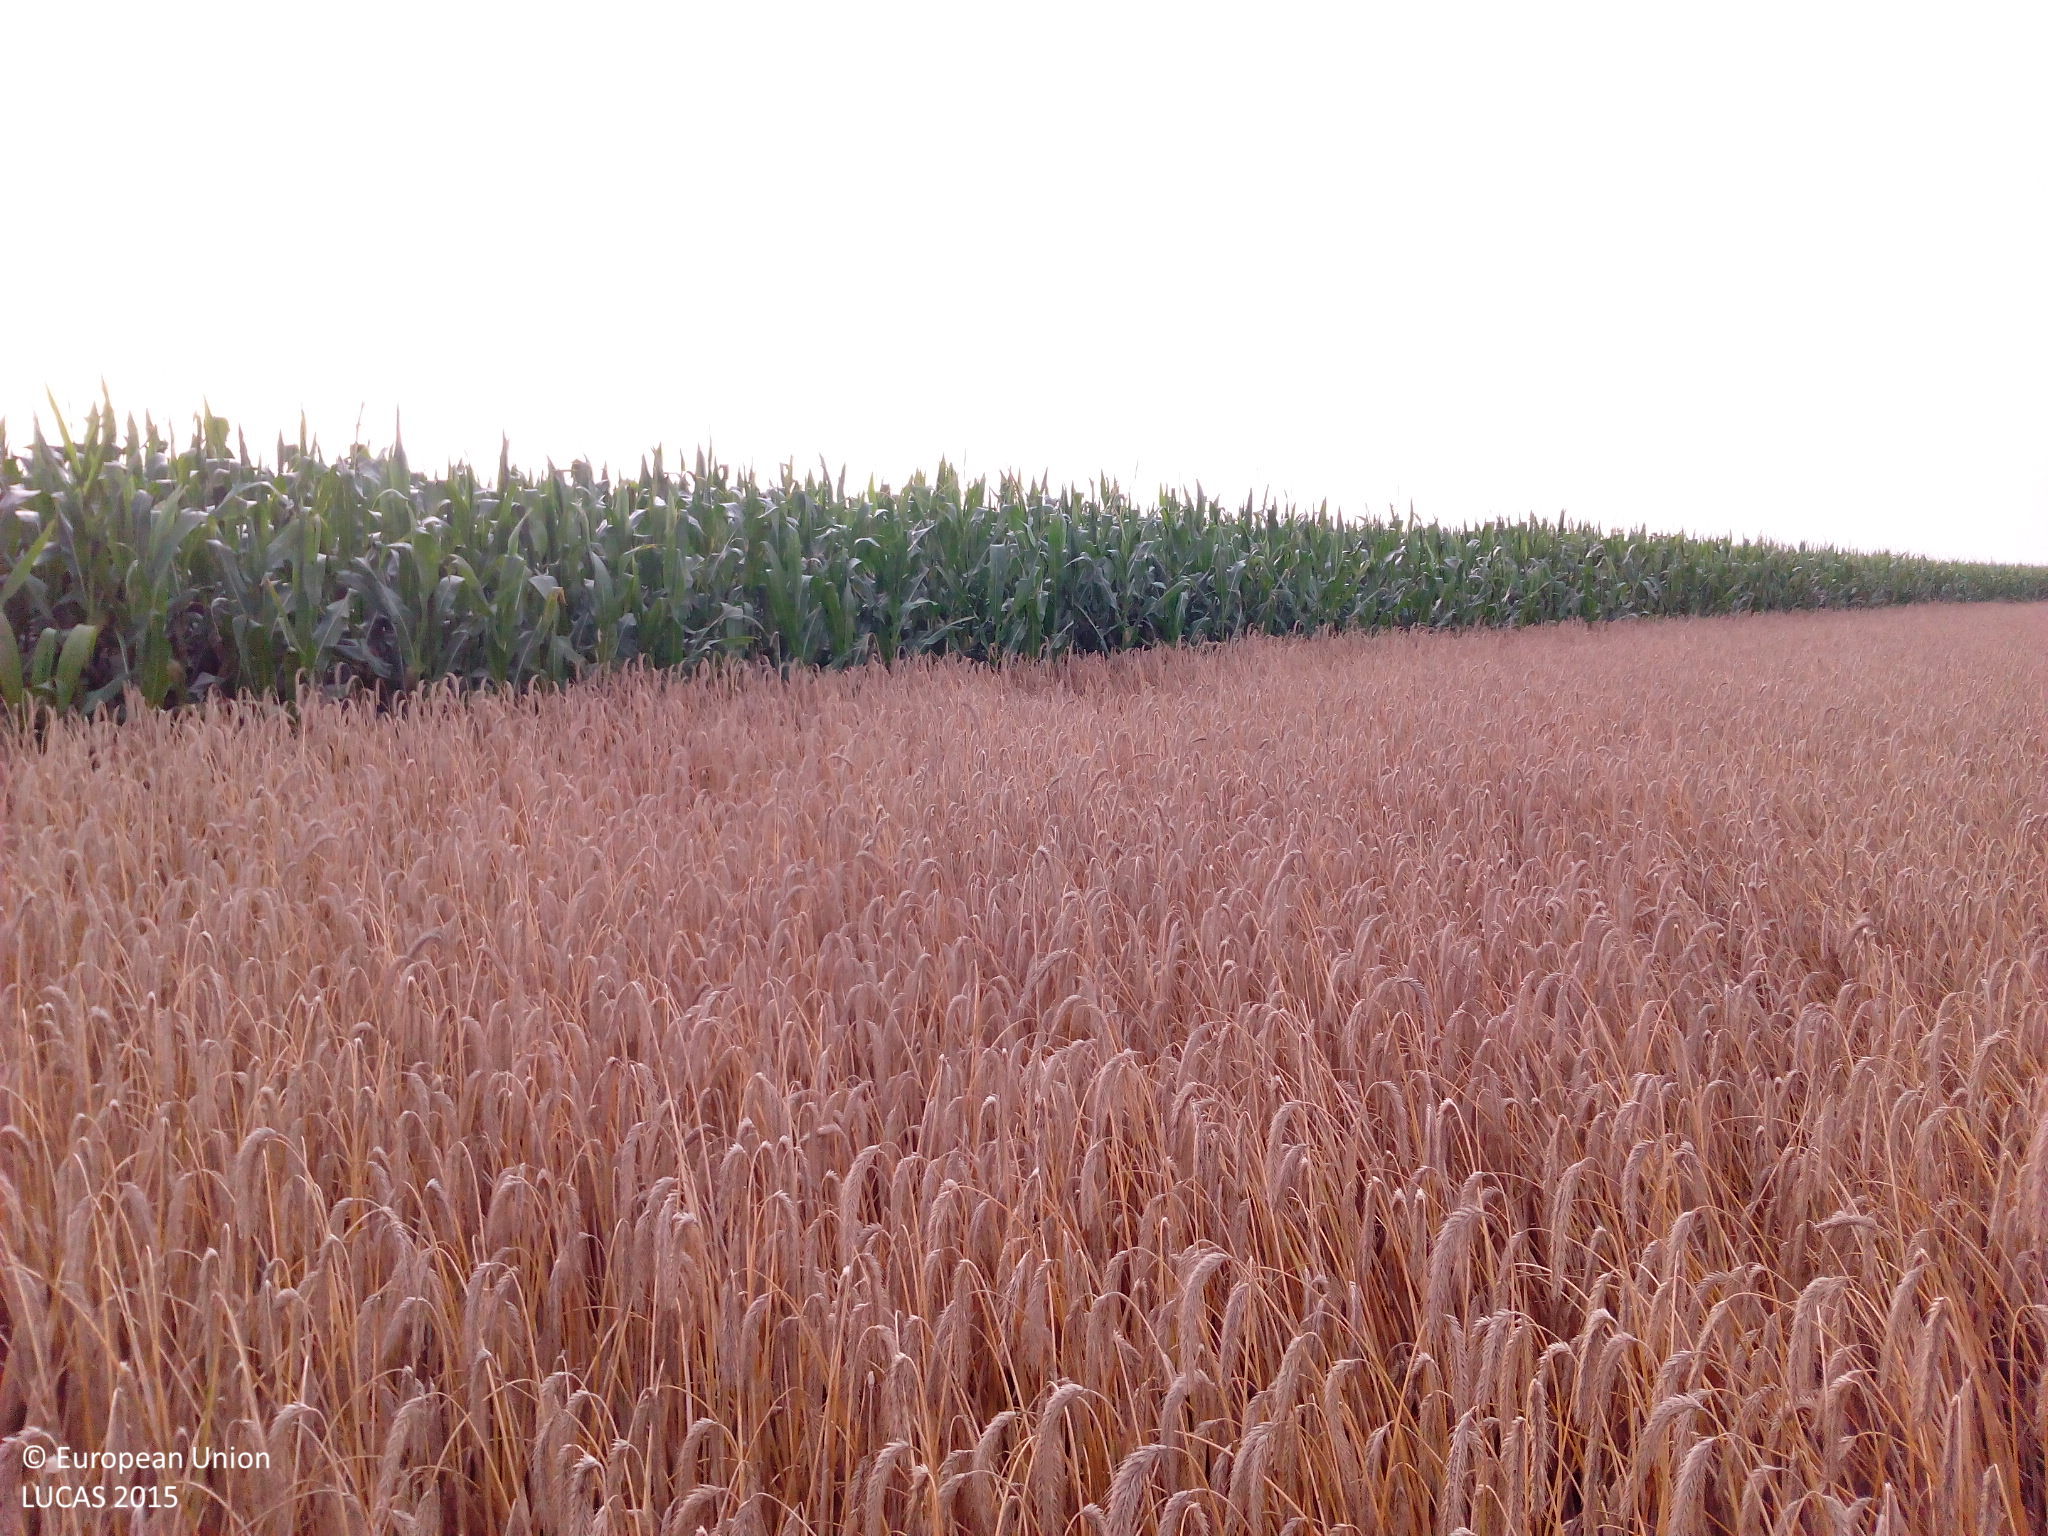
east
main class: Cropland
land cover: Rye
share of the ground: > 75 %
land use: Agriculture (excluding fallow land and kitchen gardens)
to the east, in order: Rye; Maize
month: August
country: DE
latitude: 53.9046
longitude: 9.6501
